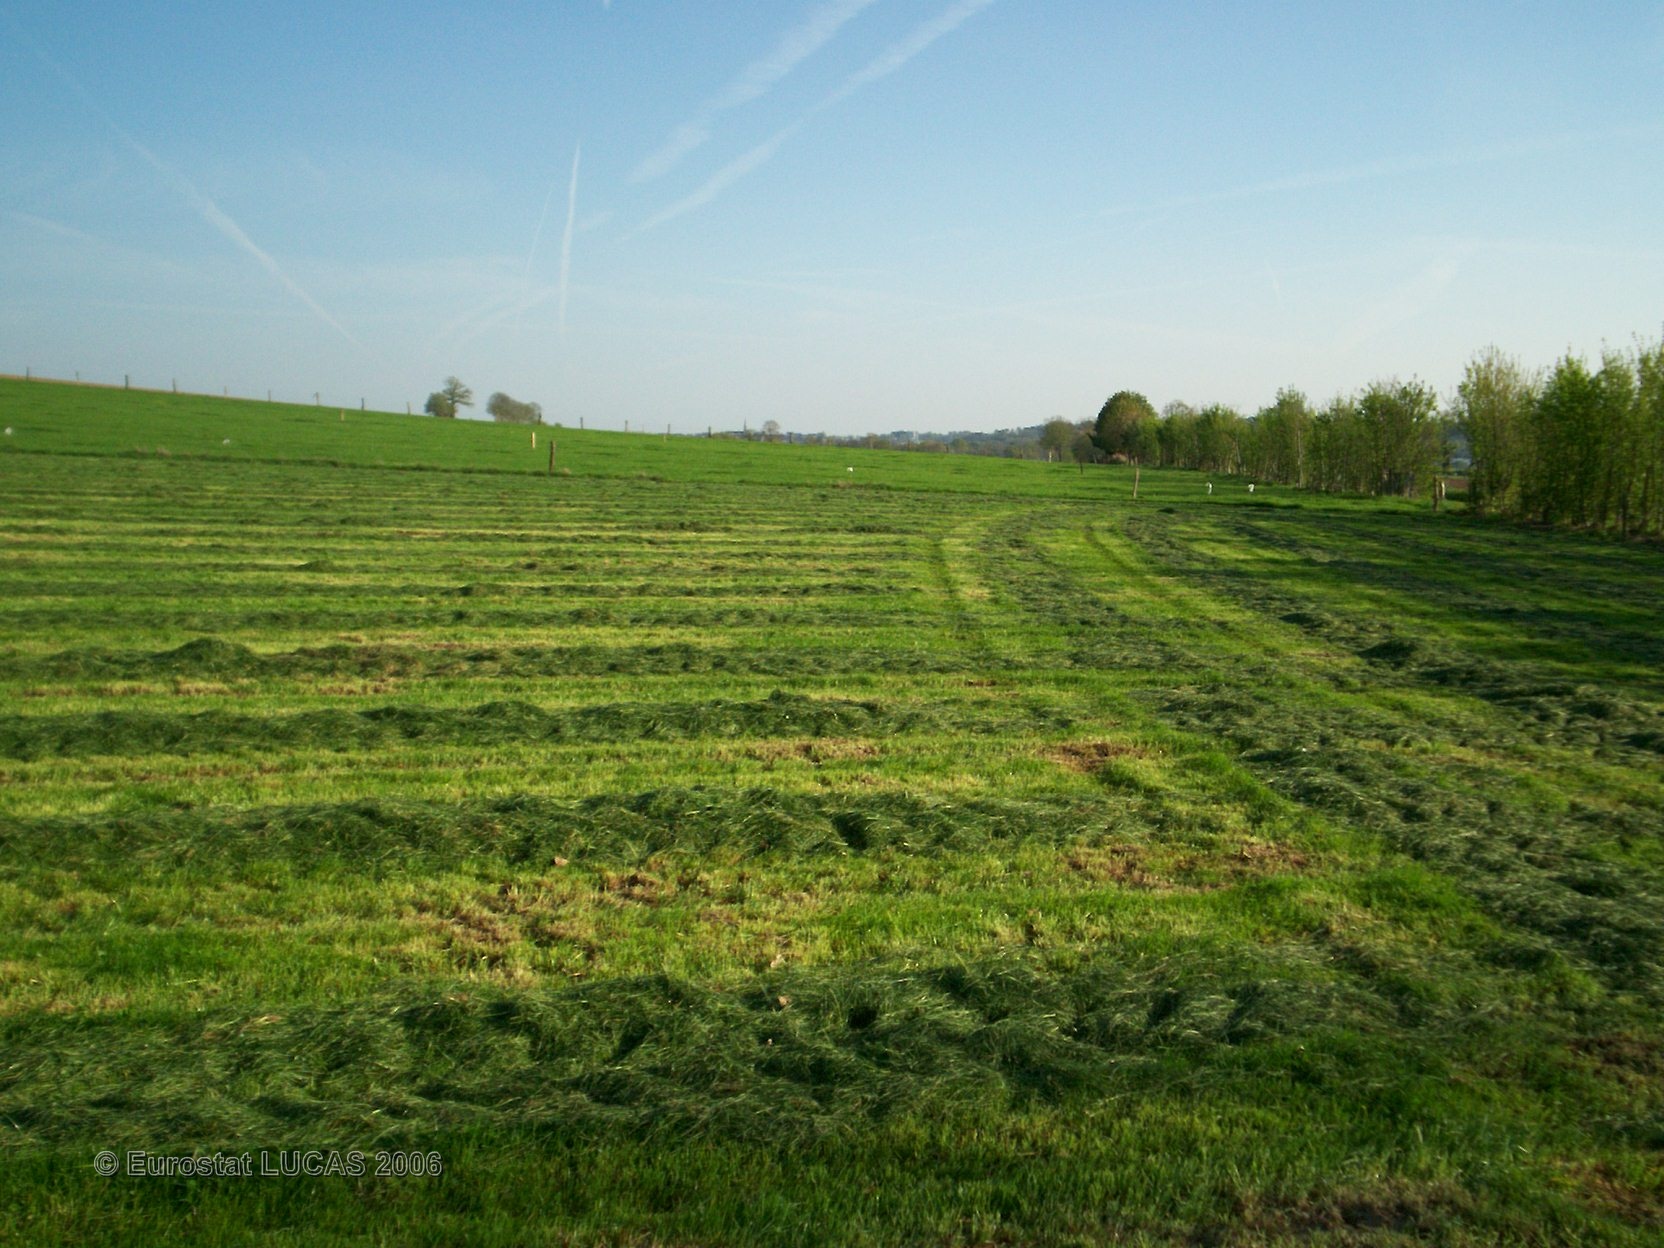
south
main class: Grassland
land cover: Grassland without tree/shrub cover
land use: Agriculture (excluding fallow land and kitchen gardens)
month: May
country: FR
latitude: 48.2523
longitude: -1.1803
